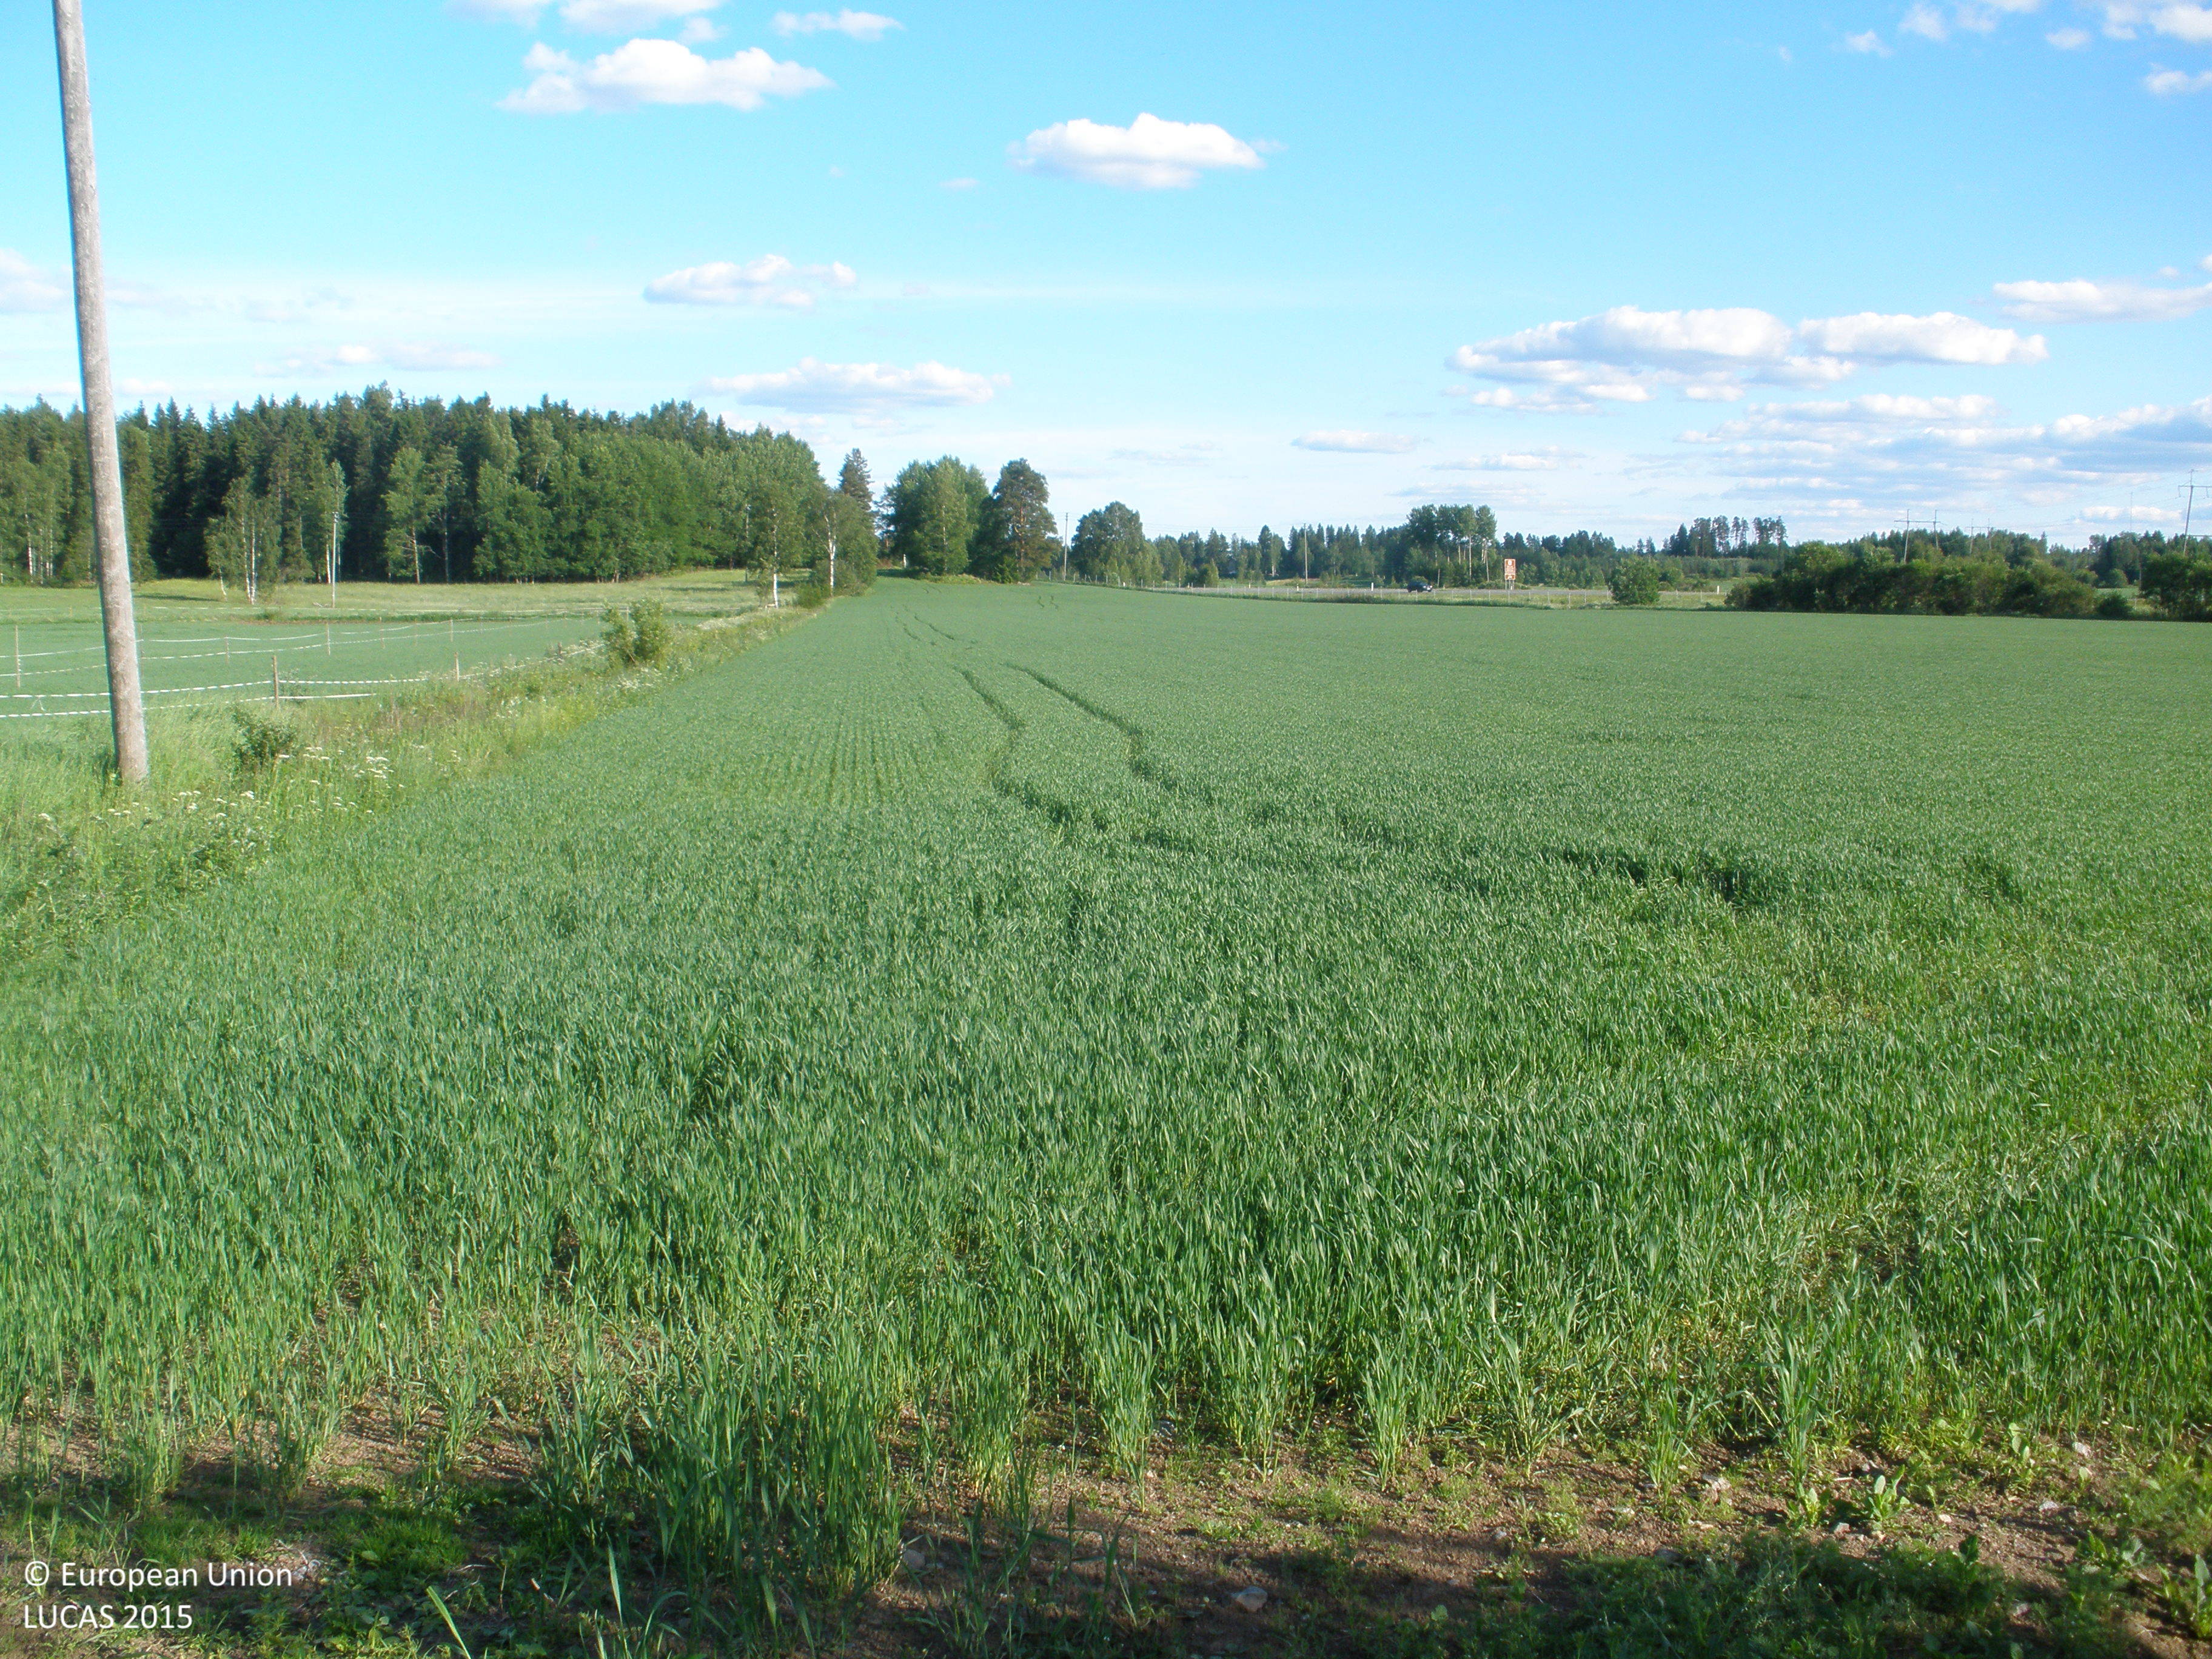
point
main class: Cropland
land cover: Common wheat
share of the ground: > 75 %
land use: Agriculture (excluding fallow land and kitchen gardens)
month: July
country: FI
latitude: 61.1704
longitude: 23.9399
